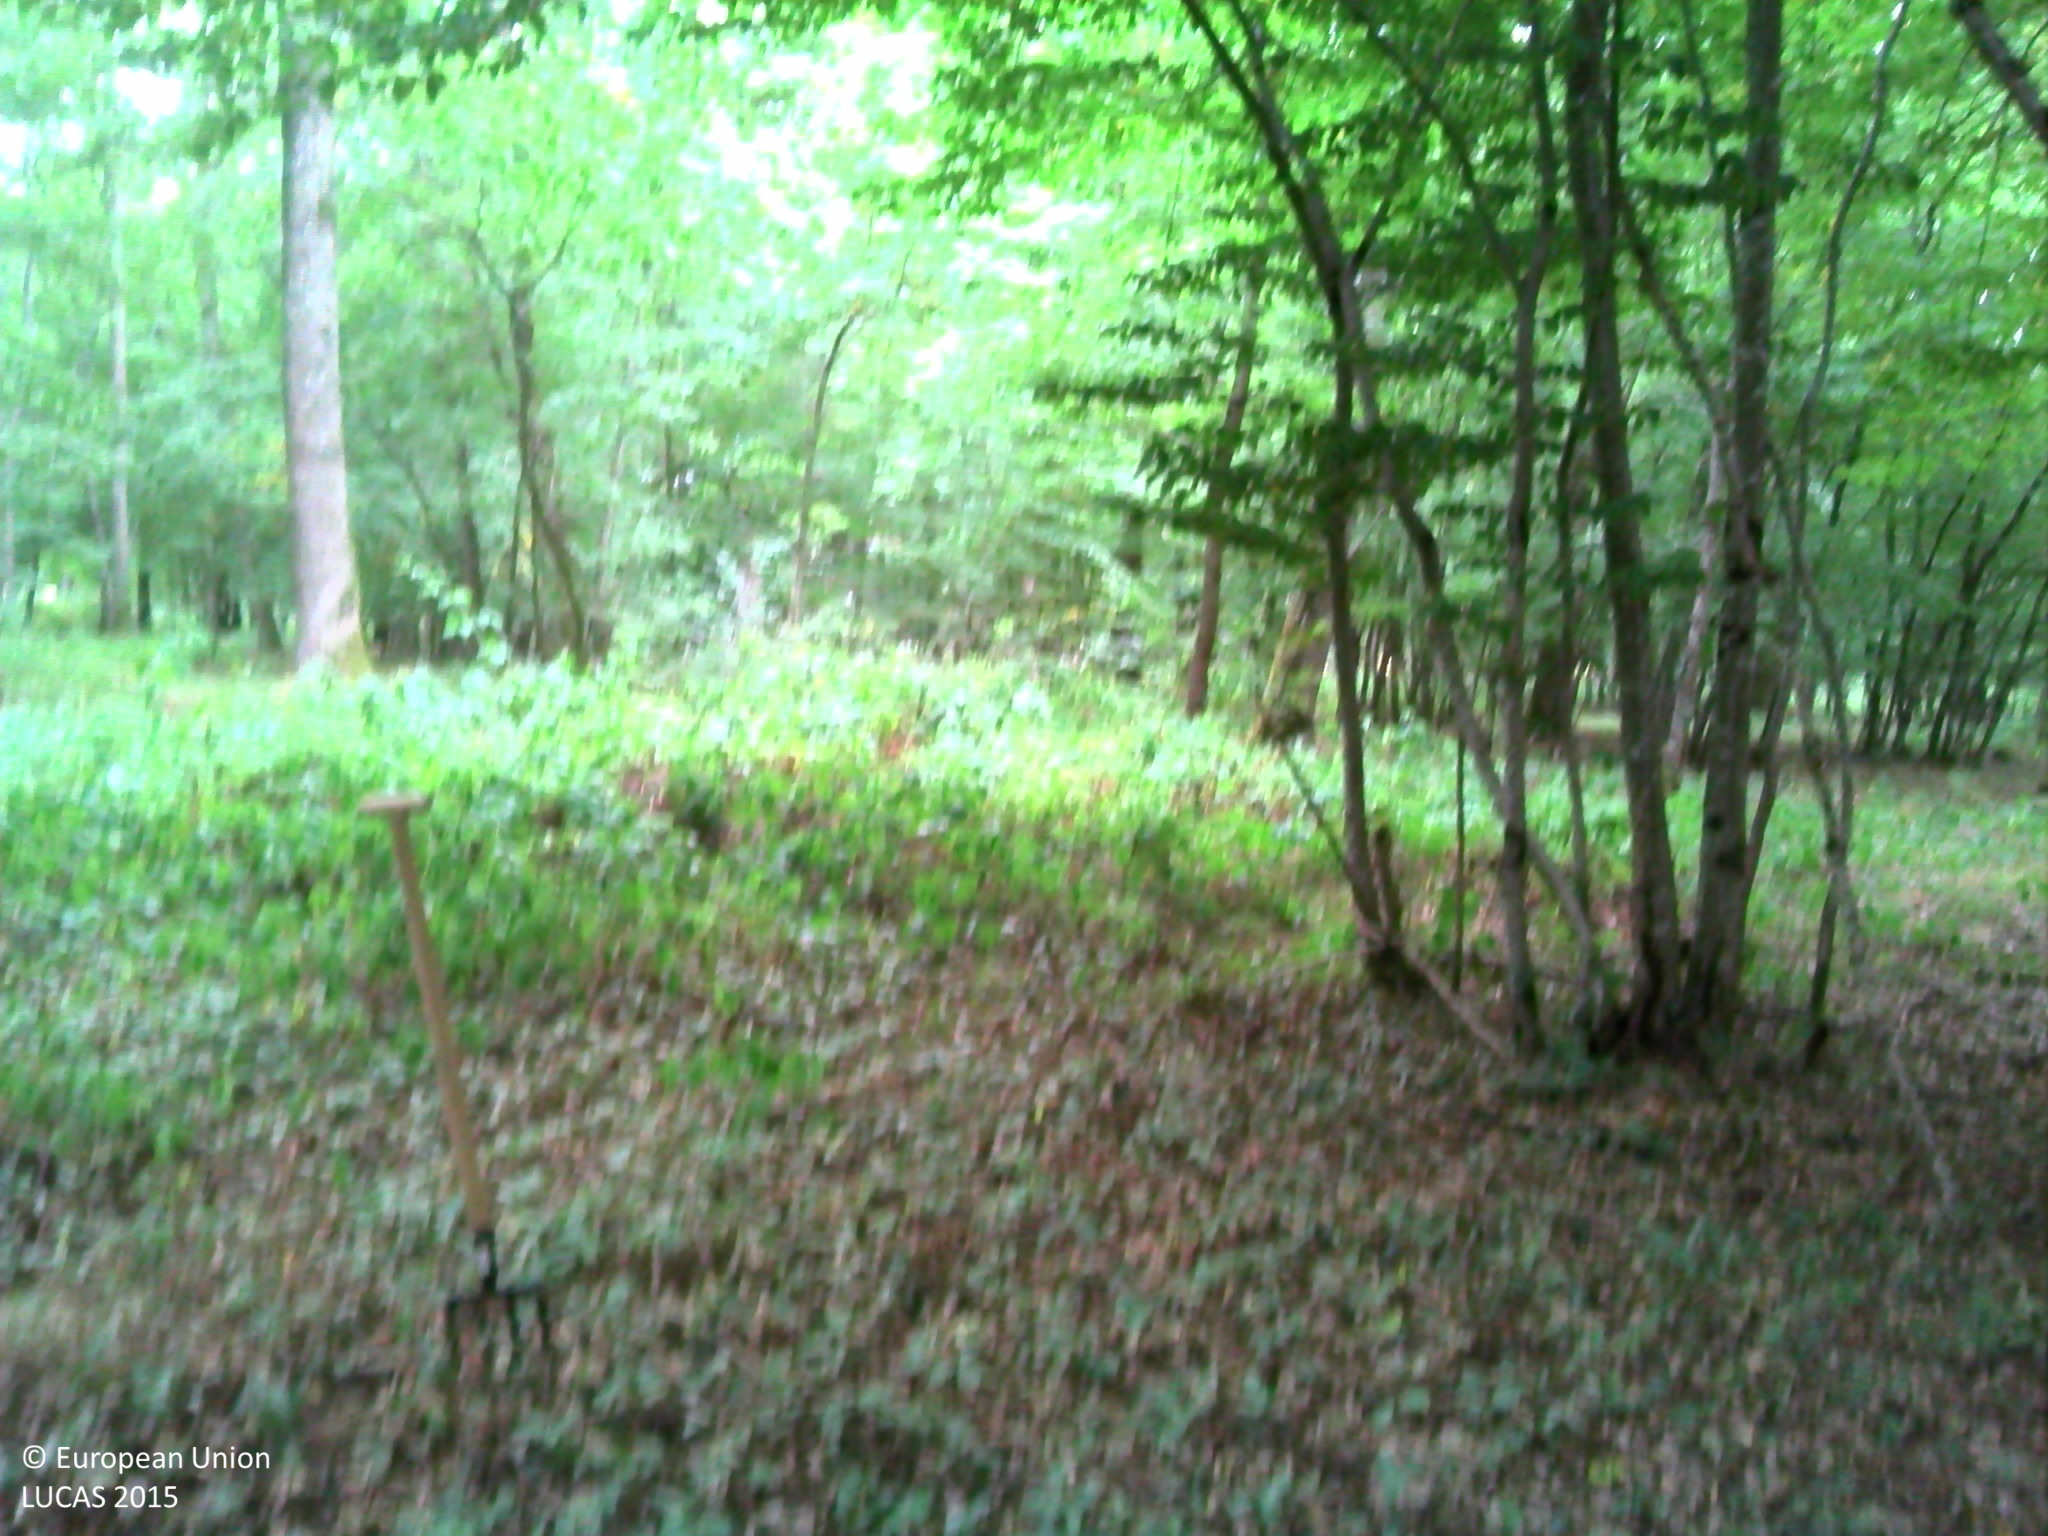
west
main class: Woodland
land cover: Broadleaved woodland
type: mesophytic deciduous forest
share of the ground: > 75 %
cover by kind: broadleaved forest trees 100 %
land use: Forestry
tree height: > 5 m
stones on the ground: < 10 %
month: July
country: FR
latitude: 46.8216
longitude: 2.1408
